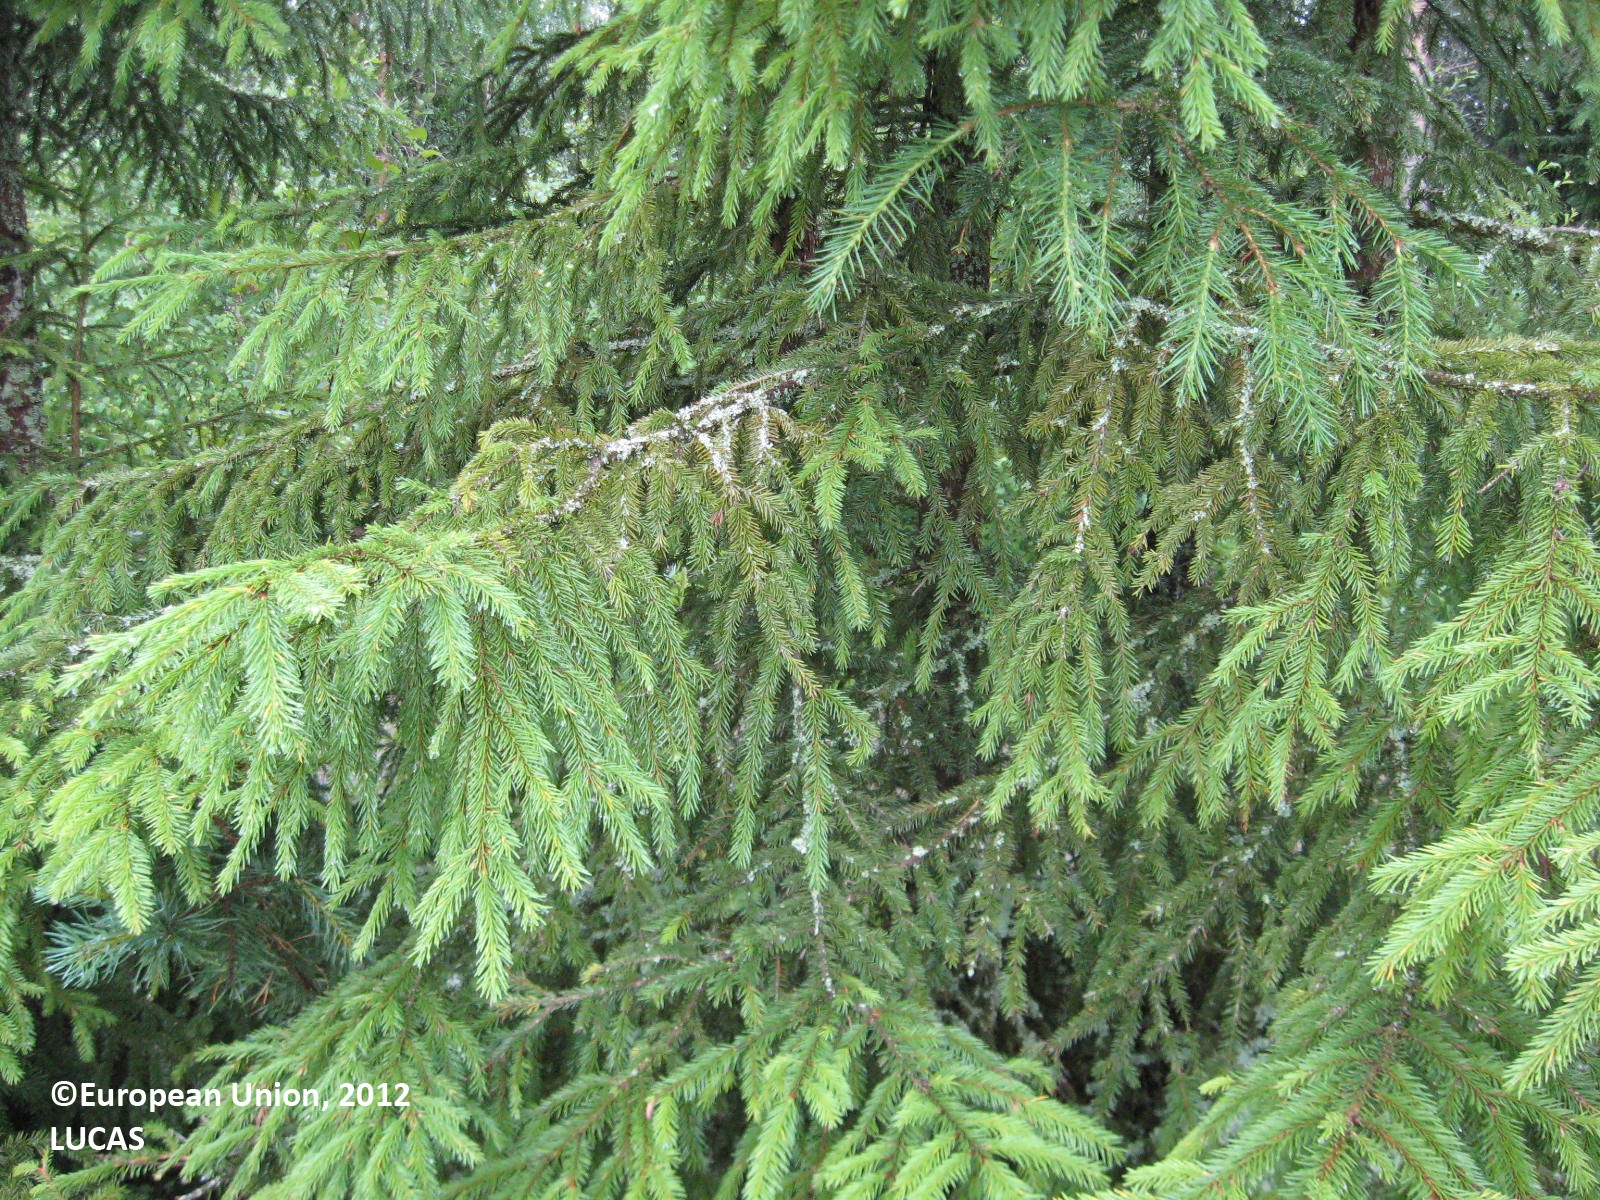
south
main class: Cropland
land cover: Barley
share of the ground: > 75 %
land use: Agriculture (excluding fallow land and kitchen gardens)
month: July
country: FI
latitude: 62.3536
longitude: 22.8309
